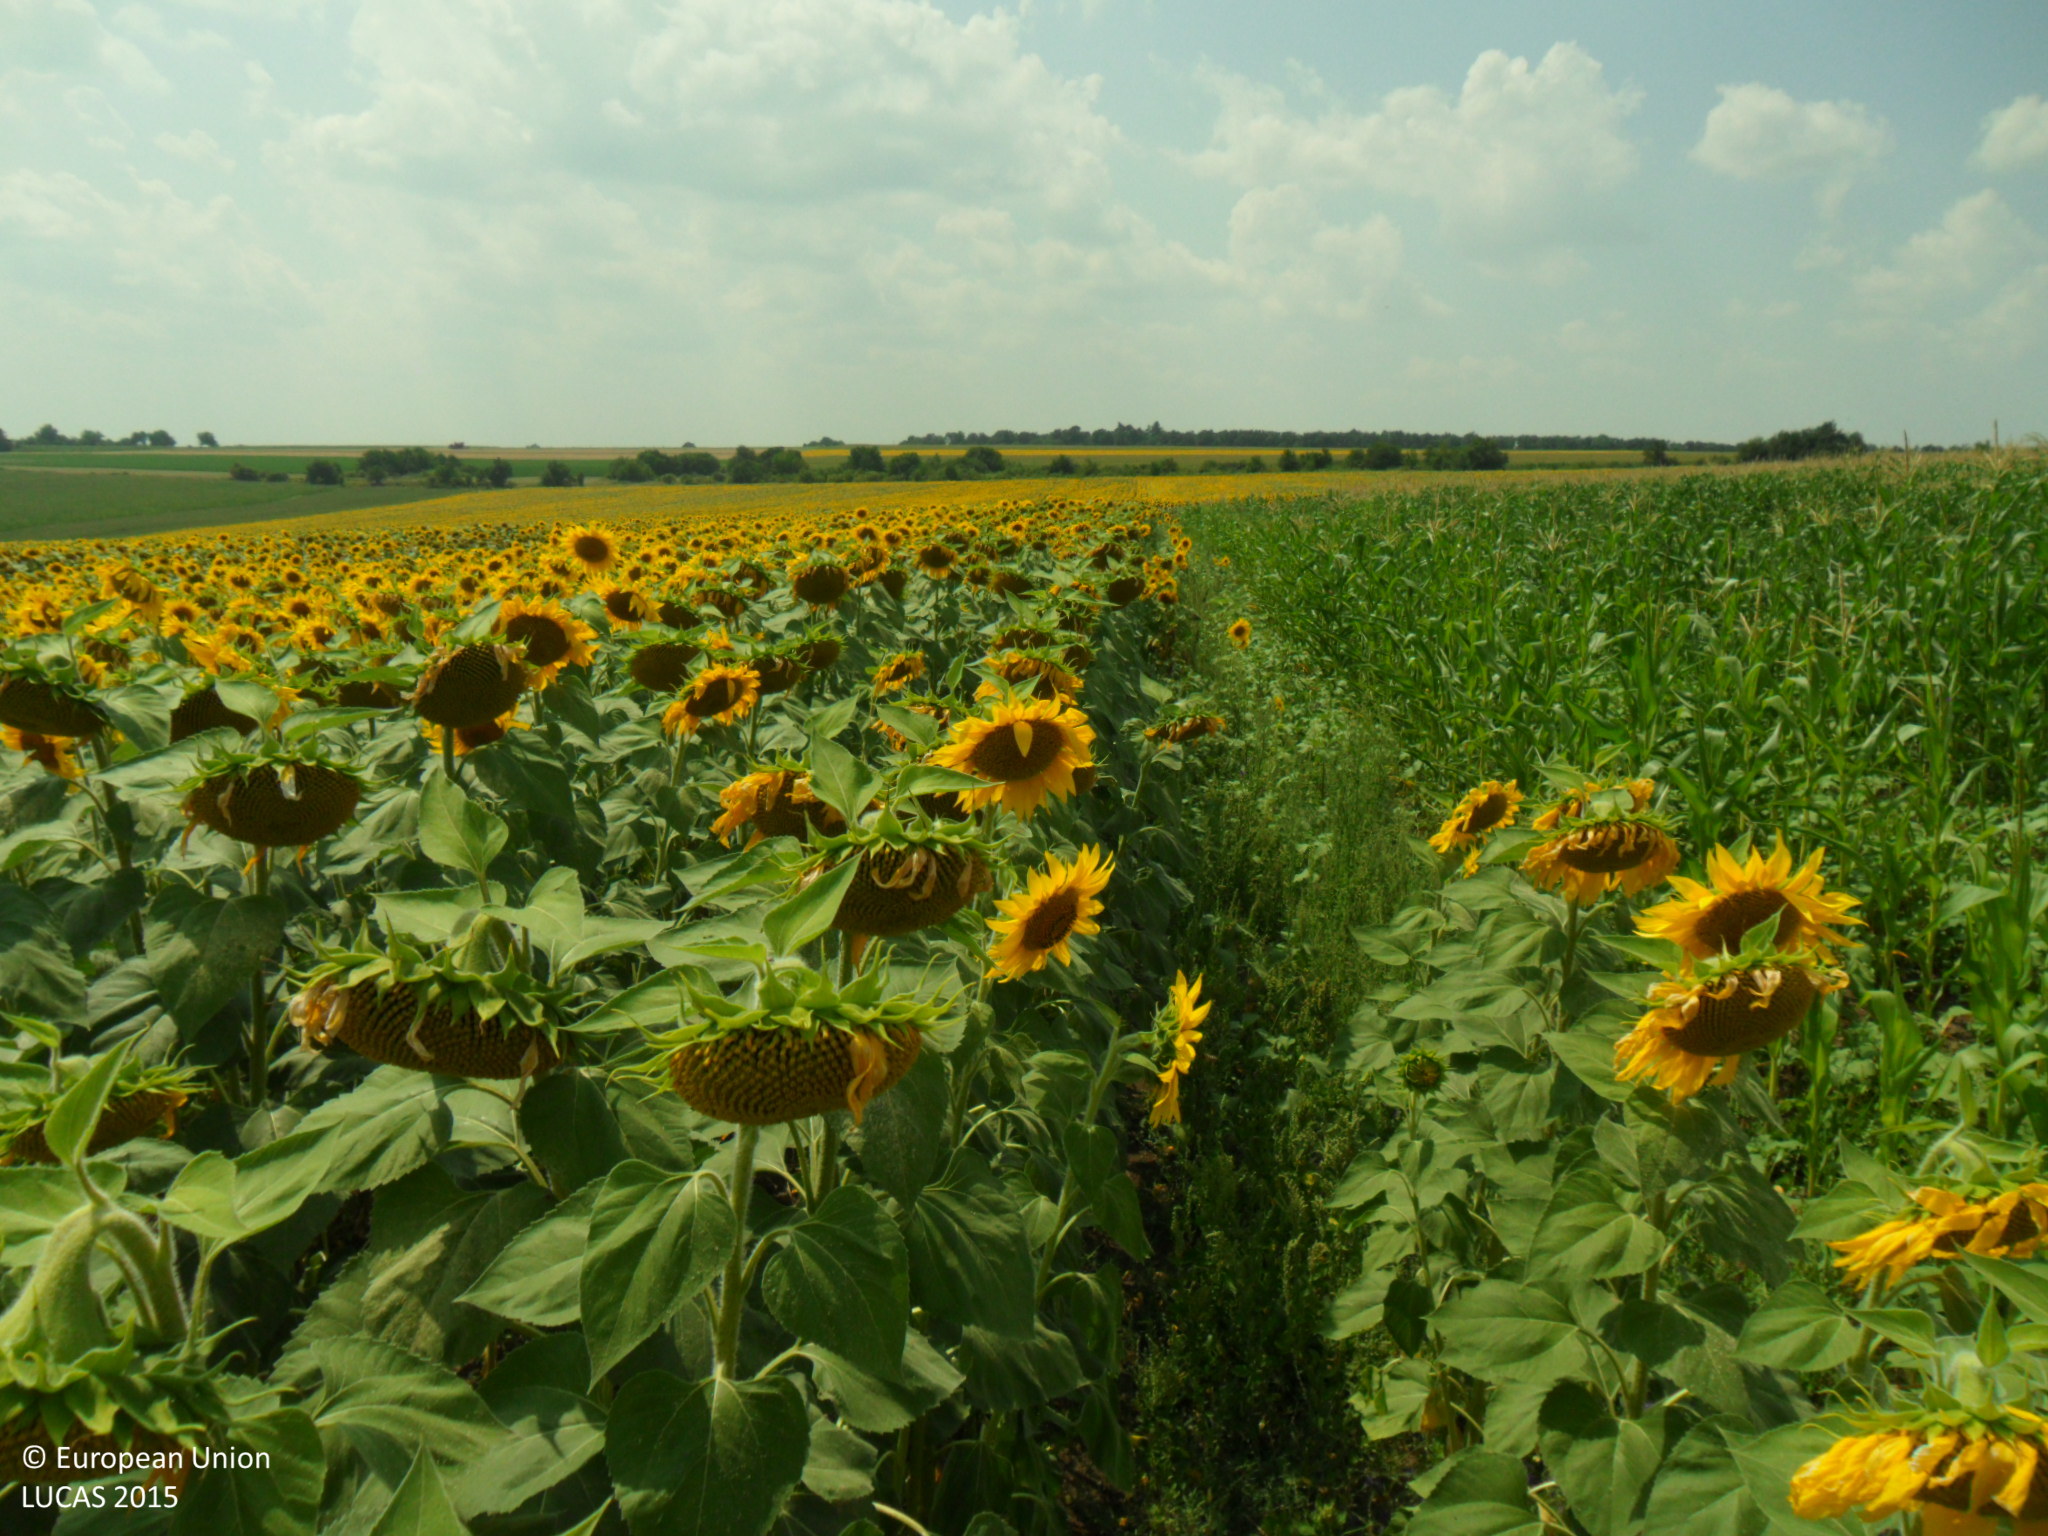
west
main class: Cropland
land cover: Sunflower
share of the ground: > 75 %
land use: Agriculture (excluding fallow land and kitchen gardens)
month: July
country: BG
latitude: 43.5973
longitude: 27.0026
